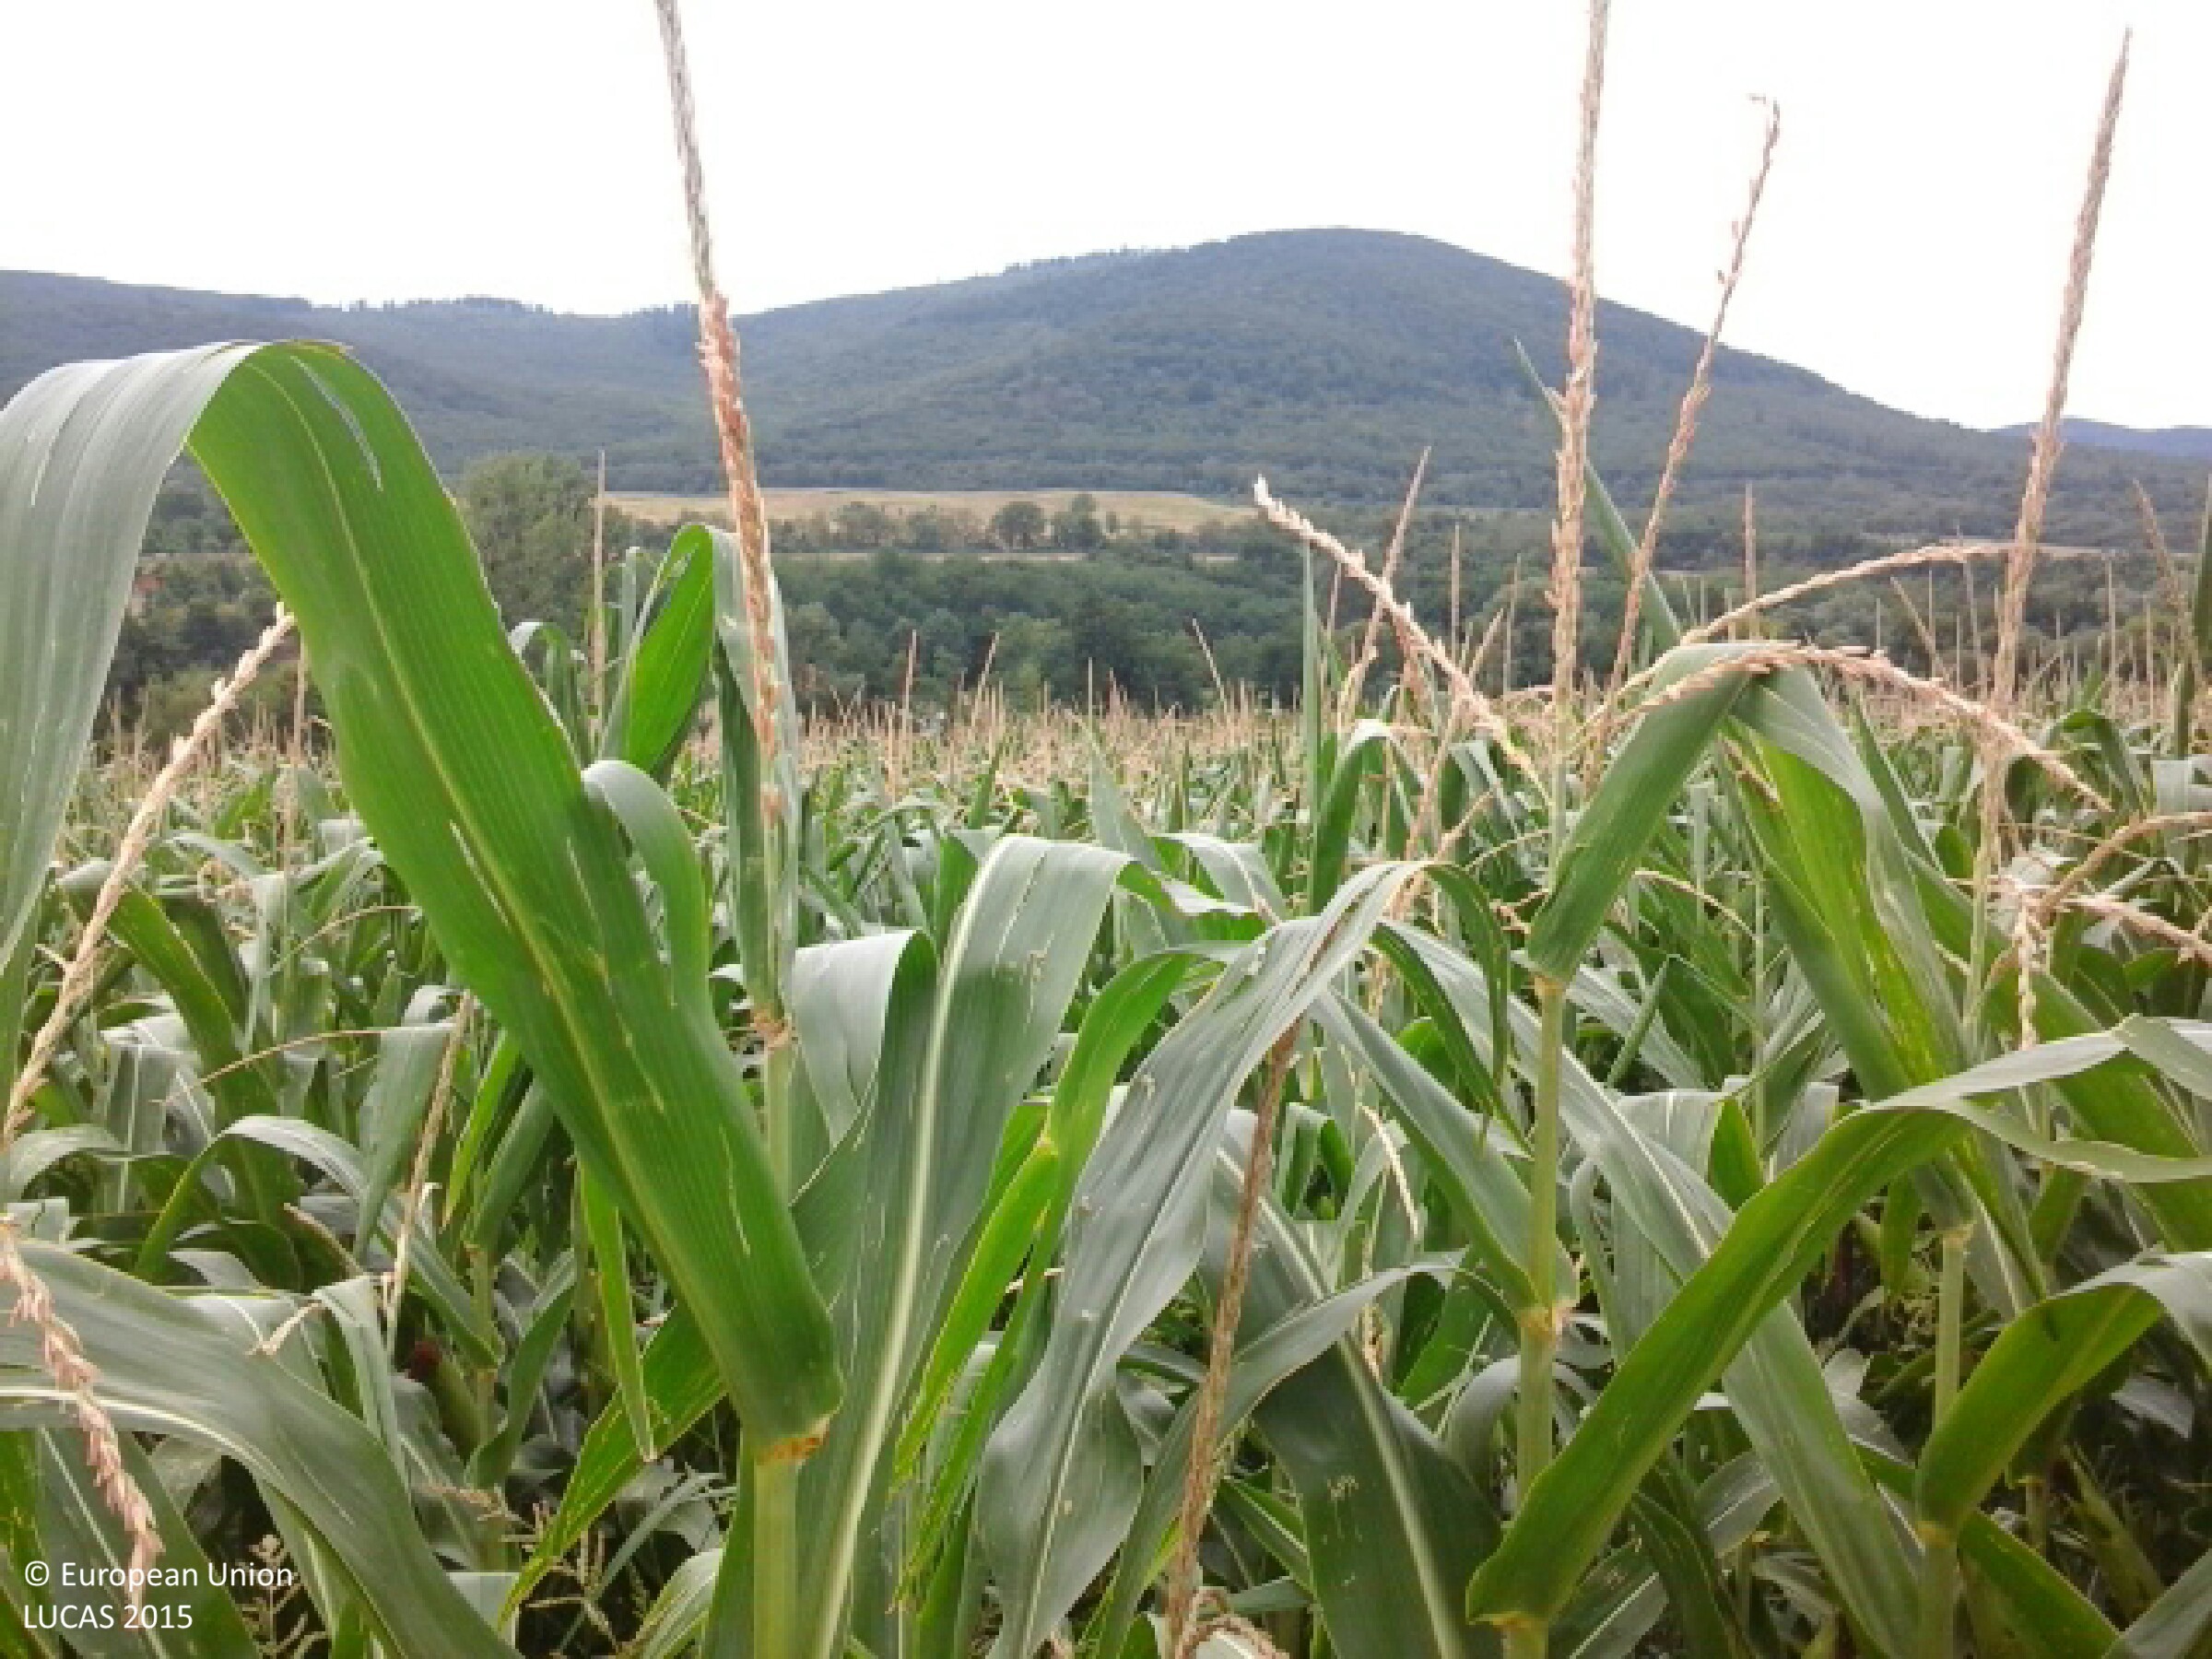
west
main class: Cropland
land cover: Maize
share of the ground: > 75 %
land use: Agriculture (excluding fallow land and kitchen gardens)
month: July
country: HU
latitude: 48.3434
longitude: 21.5288
